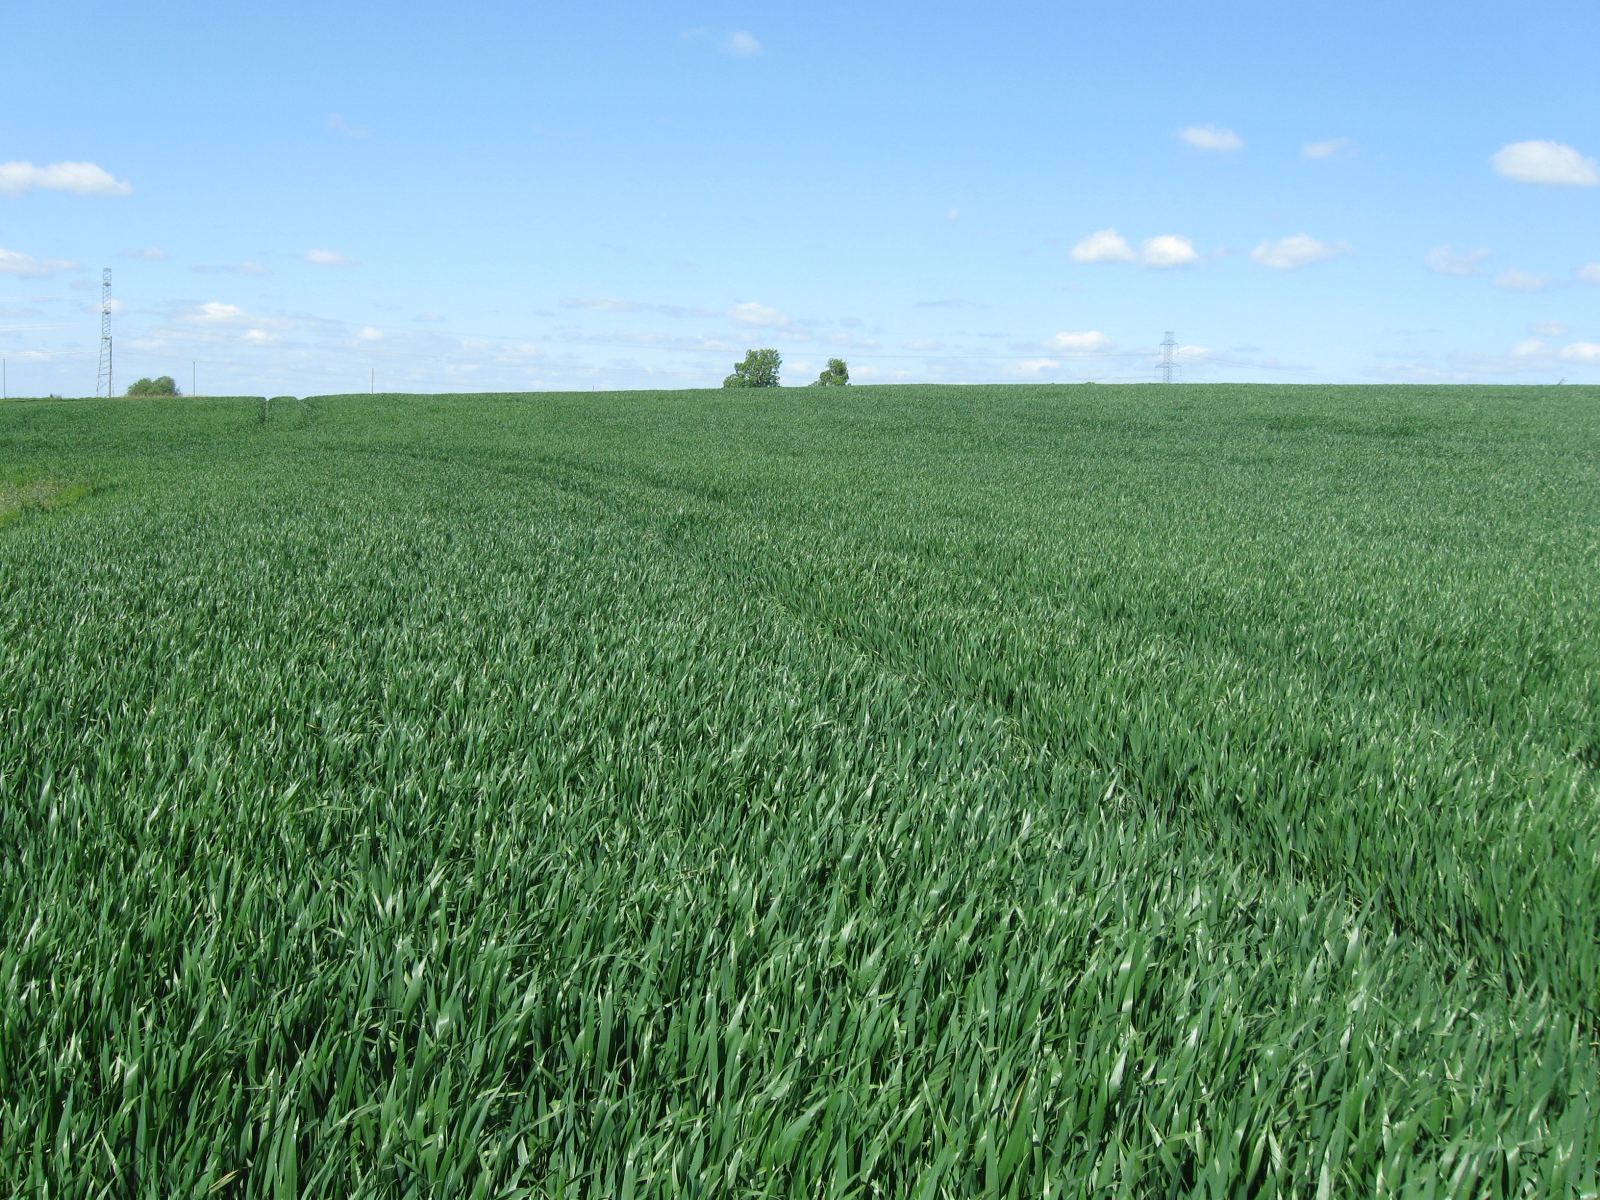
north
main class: Cropland
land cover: Common wheat
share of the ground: > 75 %
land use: Agriculture (excluding fallow land and kitchen gardens)
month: June
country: LT
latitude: 54.4123
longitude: 23.8174
